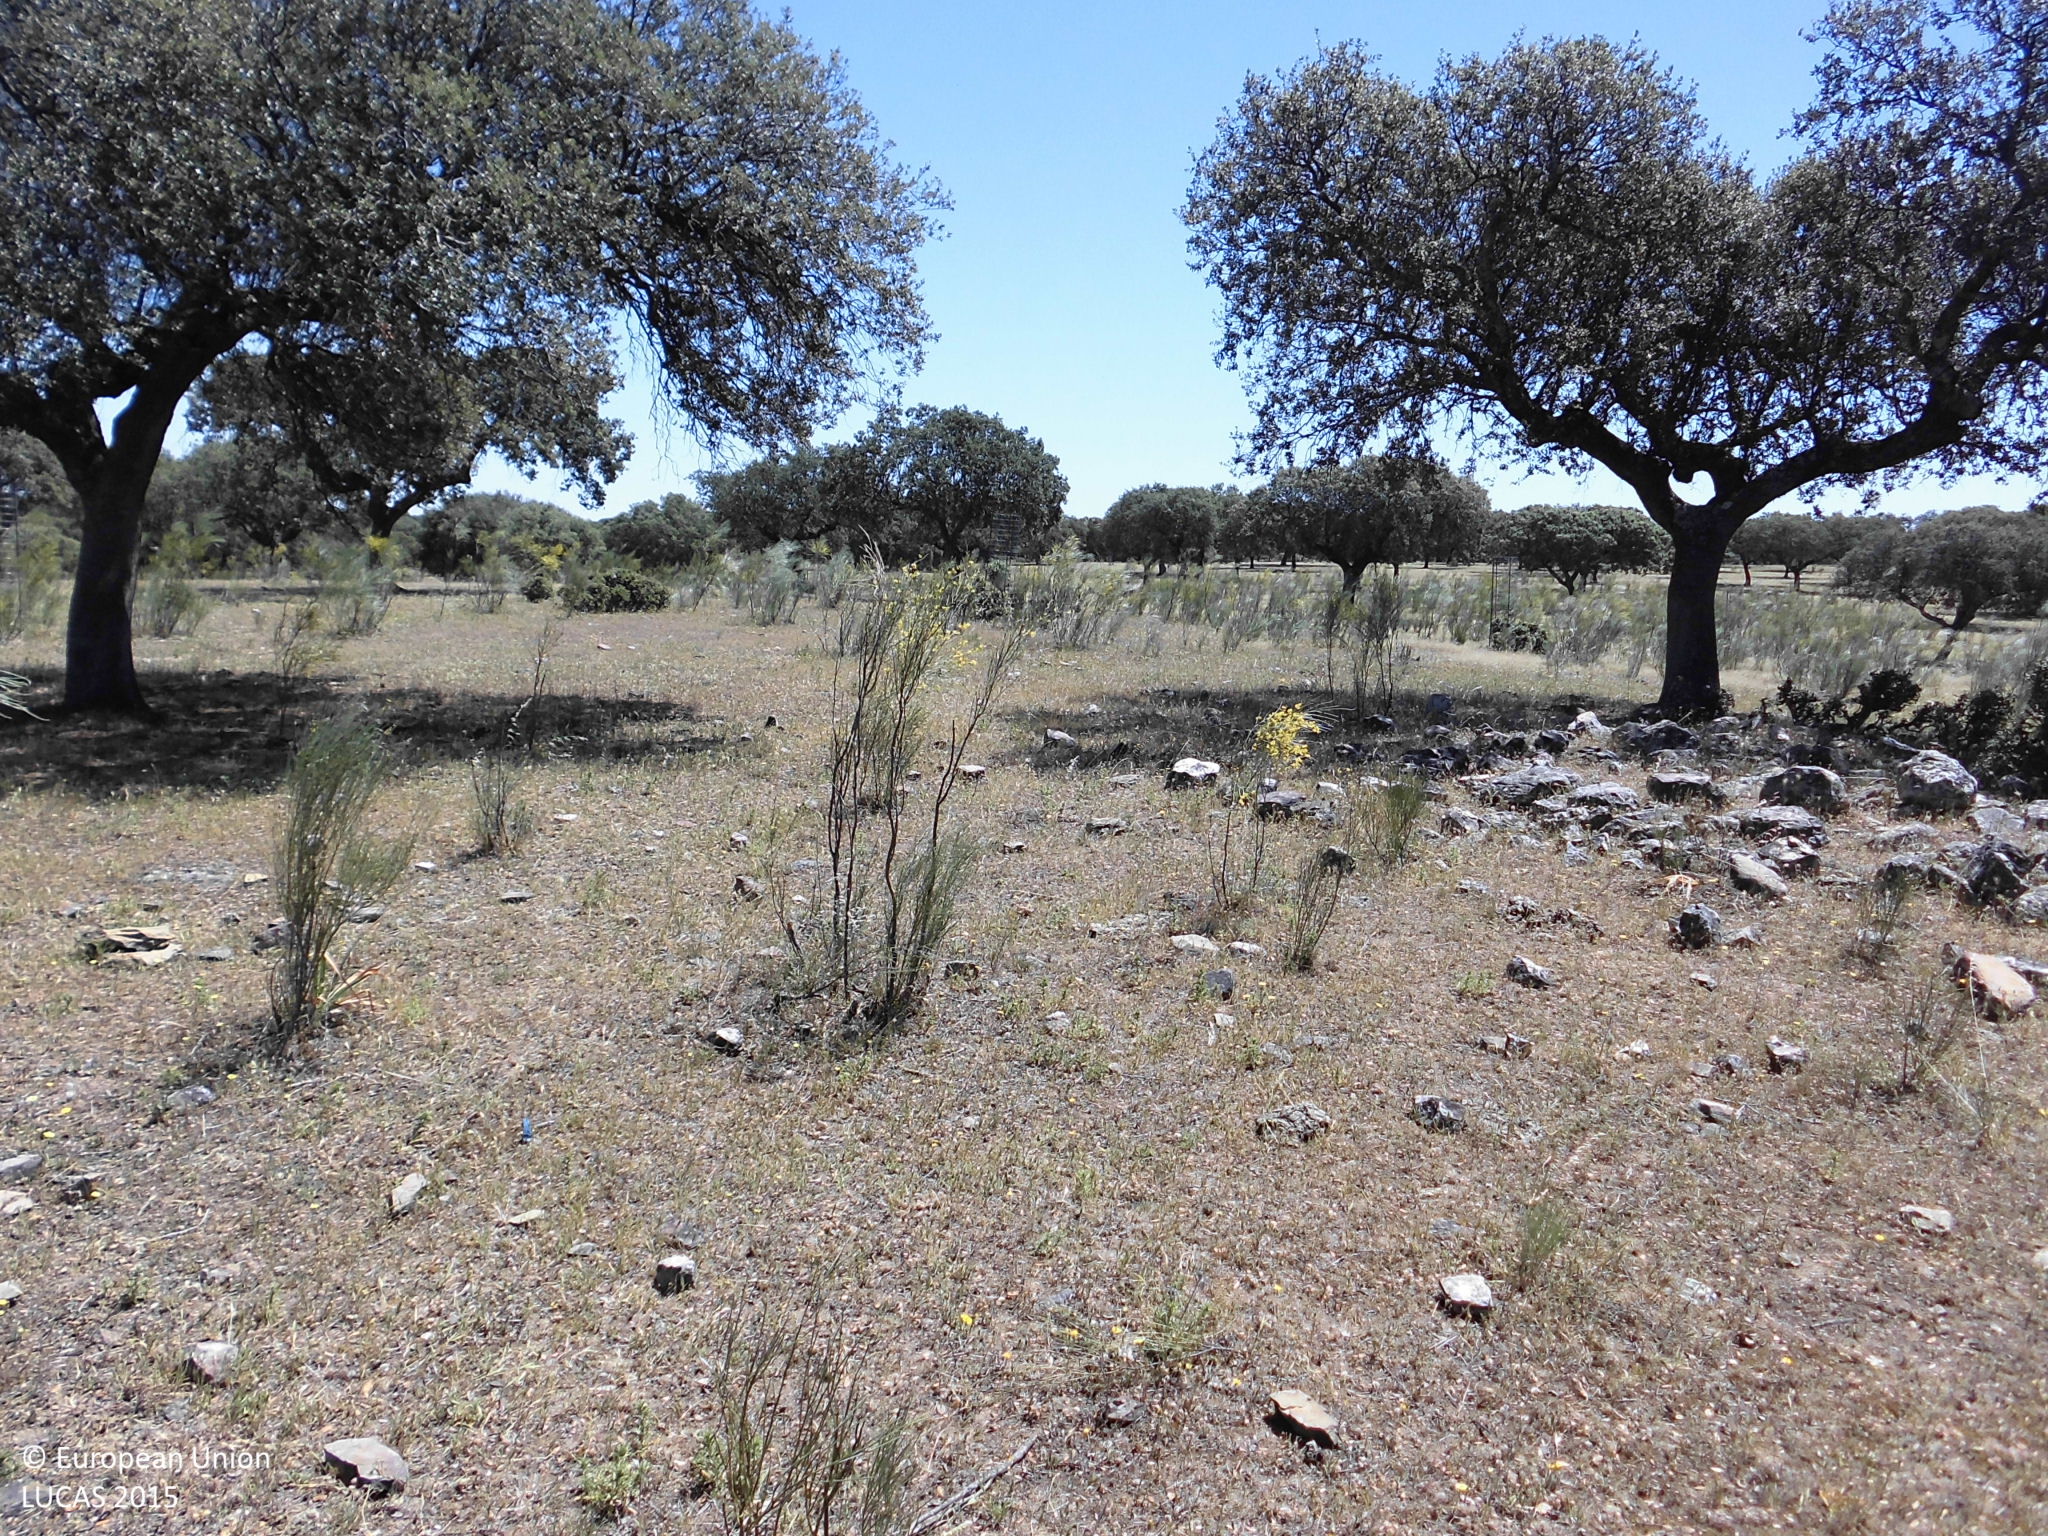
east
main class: Woodland
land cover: Broadleaved woodland
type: broadleaved evergreen forest
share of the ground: 25 - 50 %
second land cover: Grassland without tree/shrub cover
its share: > 75 %
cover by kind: herbaceous plants 50 %, broadleaved forest trees 35 %, shrubs 15 %
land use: Forestry
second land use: Agriculture (excluding fallow land and kitchen gardens)
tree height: > 5 m
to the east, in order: Broadleaved woodland; Grassland without tree/shrub cover
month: May
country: ES
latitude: 39.4379
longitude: -6.9854
